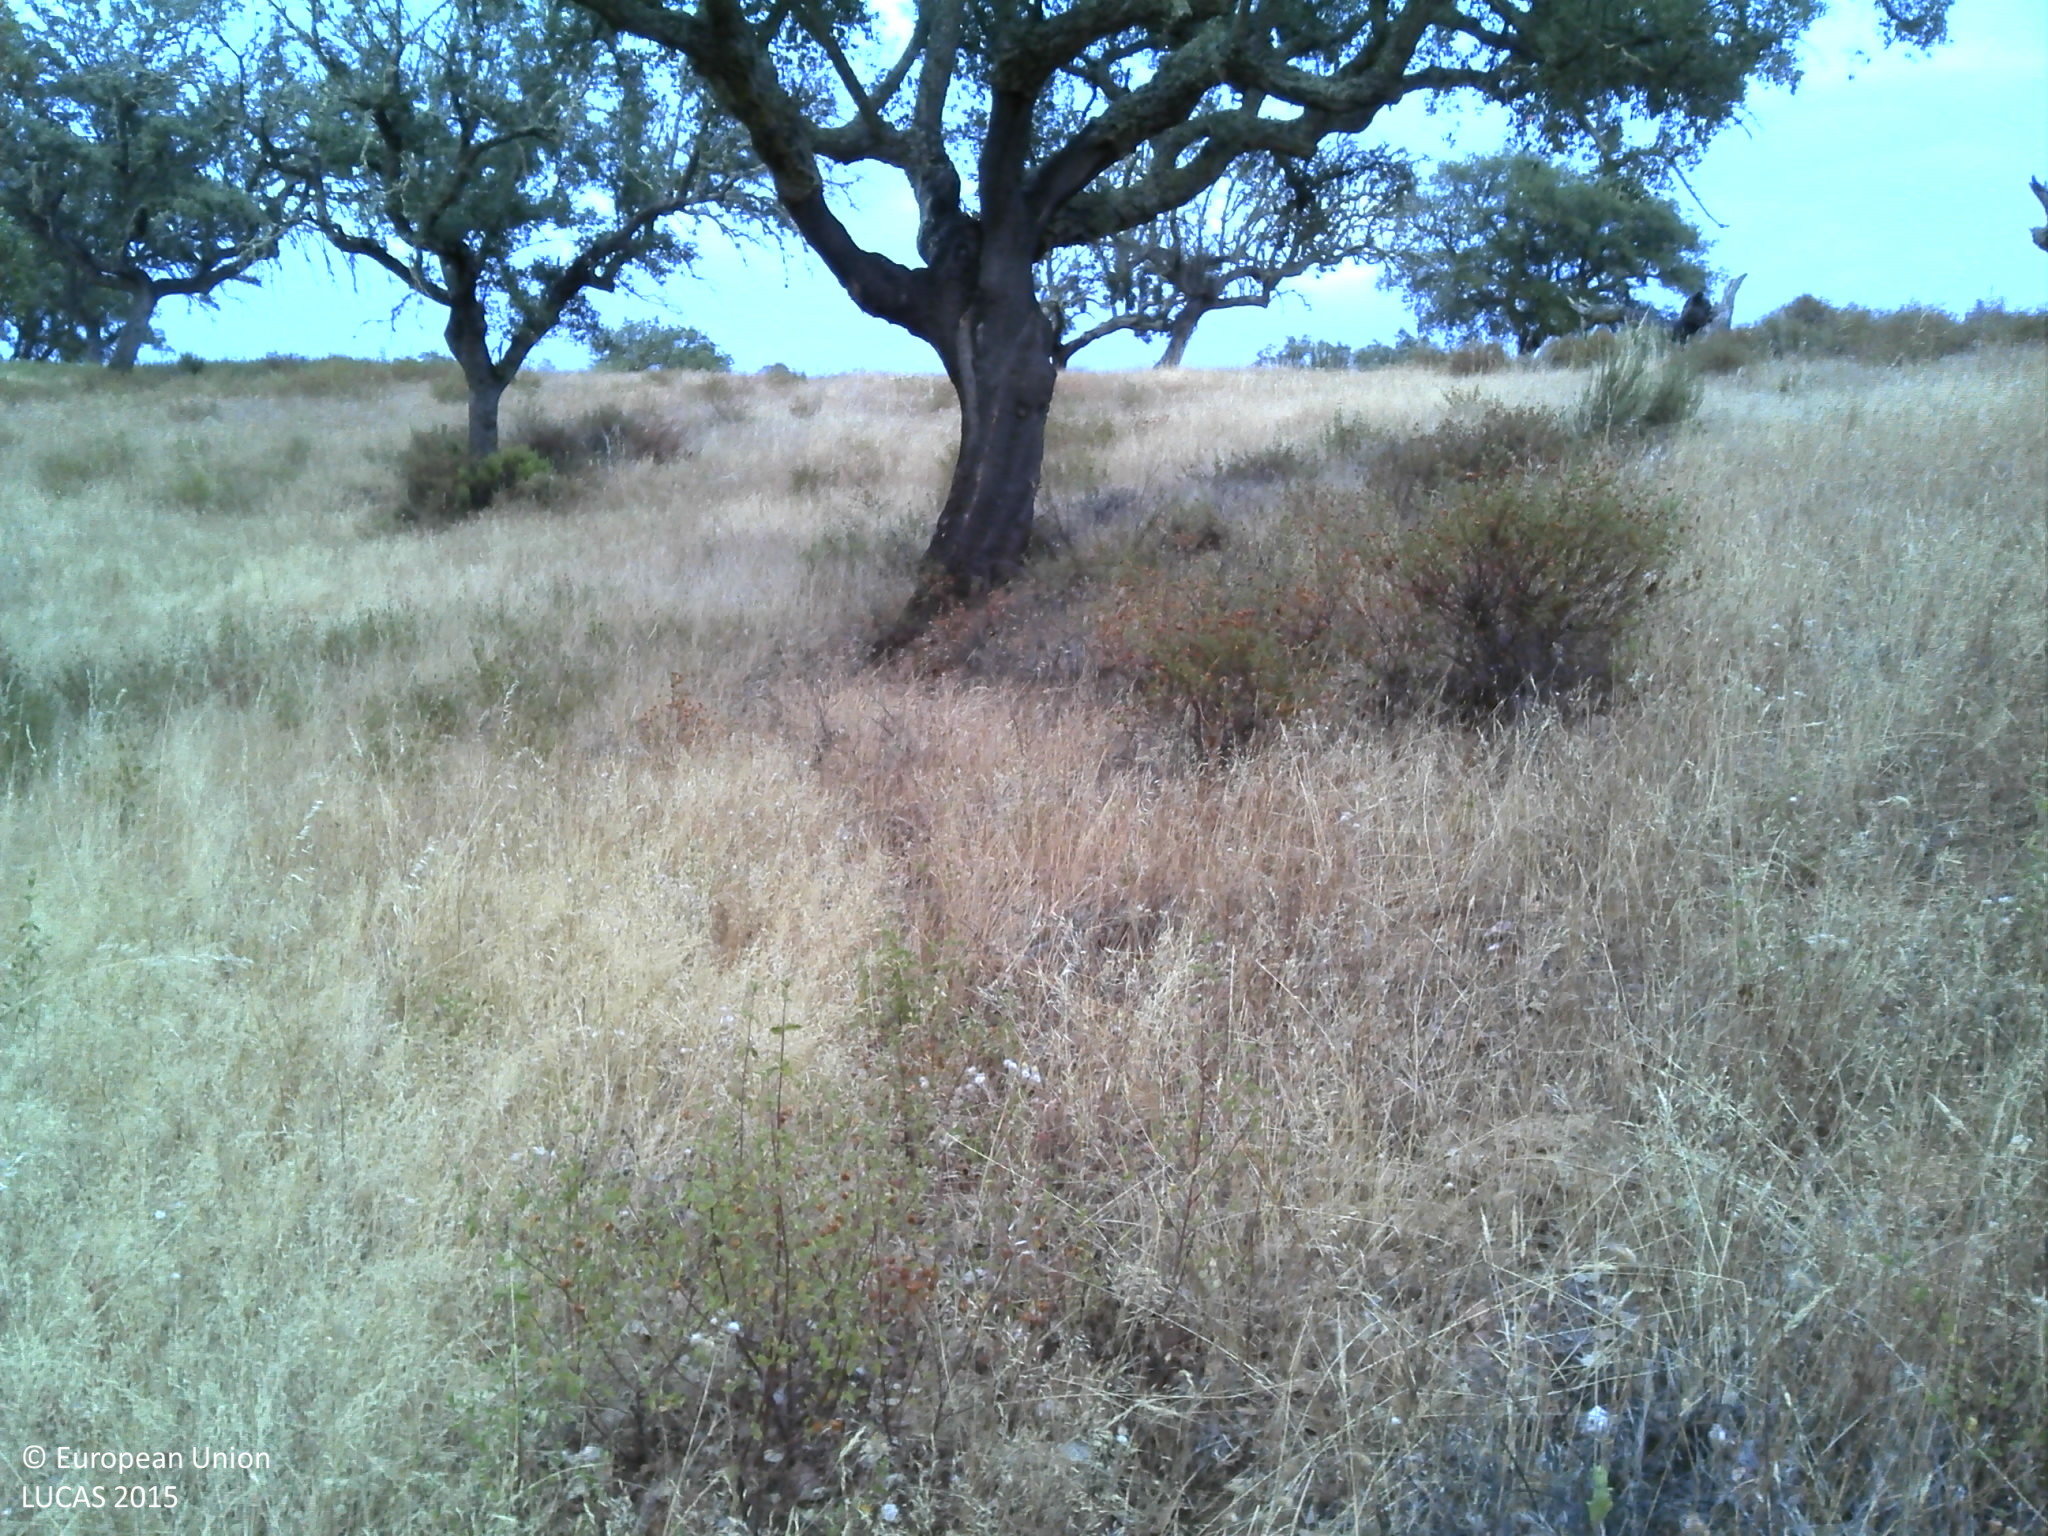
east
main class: Woodland
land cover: Broadleaved woodland
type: broadleaved evergreen forest
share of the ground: 25 - 50 %
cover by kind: herbaceous plants 50 %, broadleaved forest trees 45 %, unconsolidated bare surface 5 %
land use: Forestry
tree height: > 5 m
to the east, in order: Broadleaved woodland; Grassland without tree/shrub cover; Broadleaved woodland; Grassland without tree/shrub cover; Broadleaved woodland
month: June
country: PT
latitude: 37.8398
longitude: -7.5506
